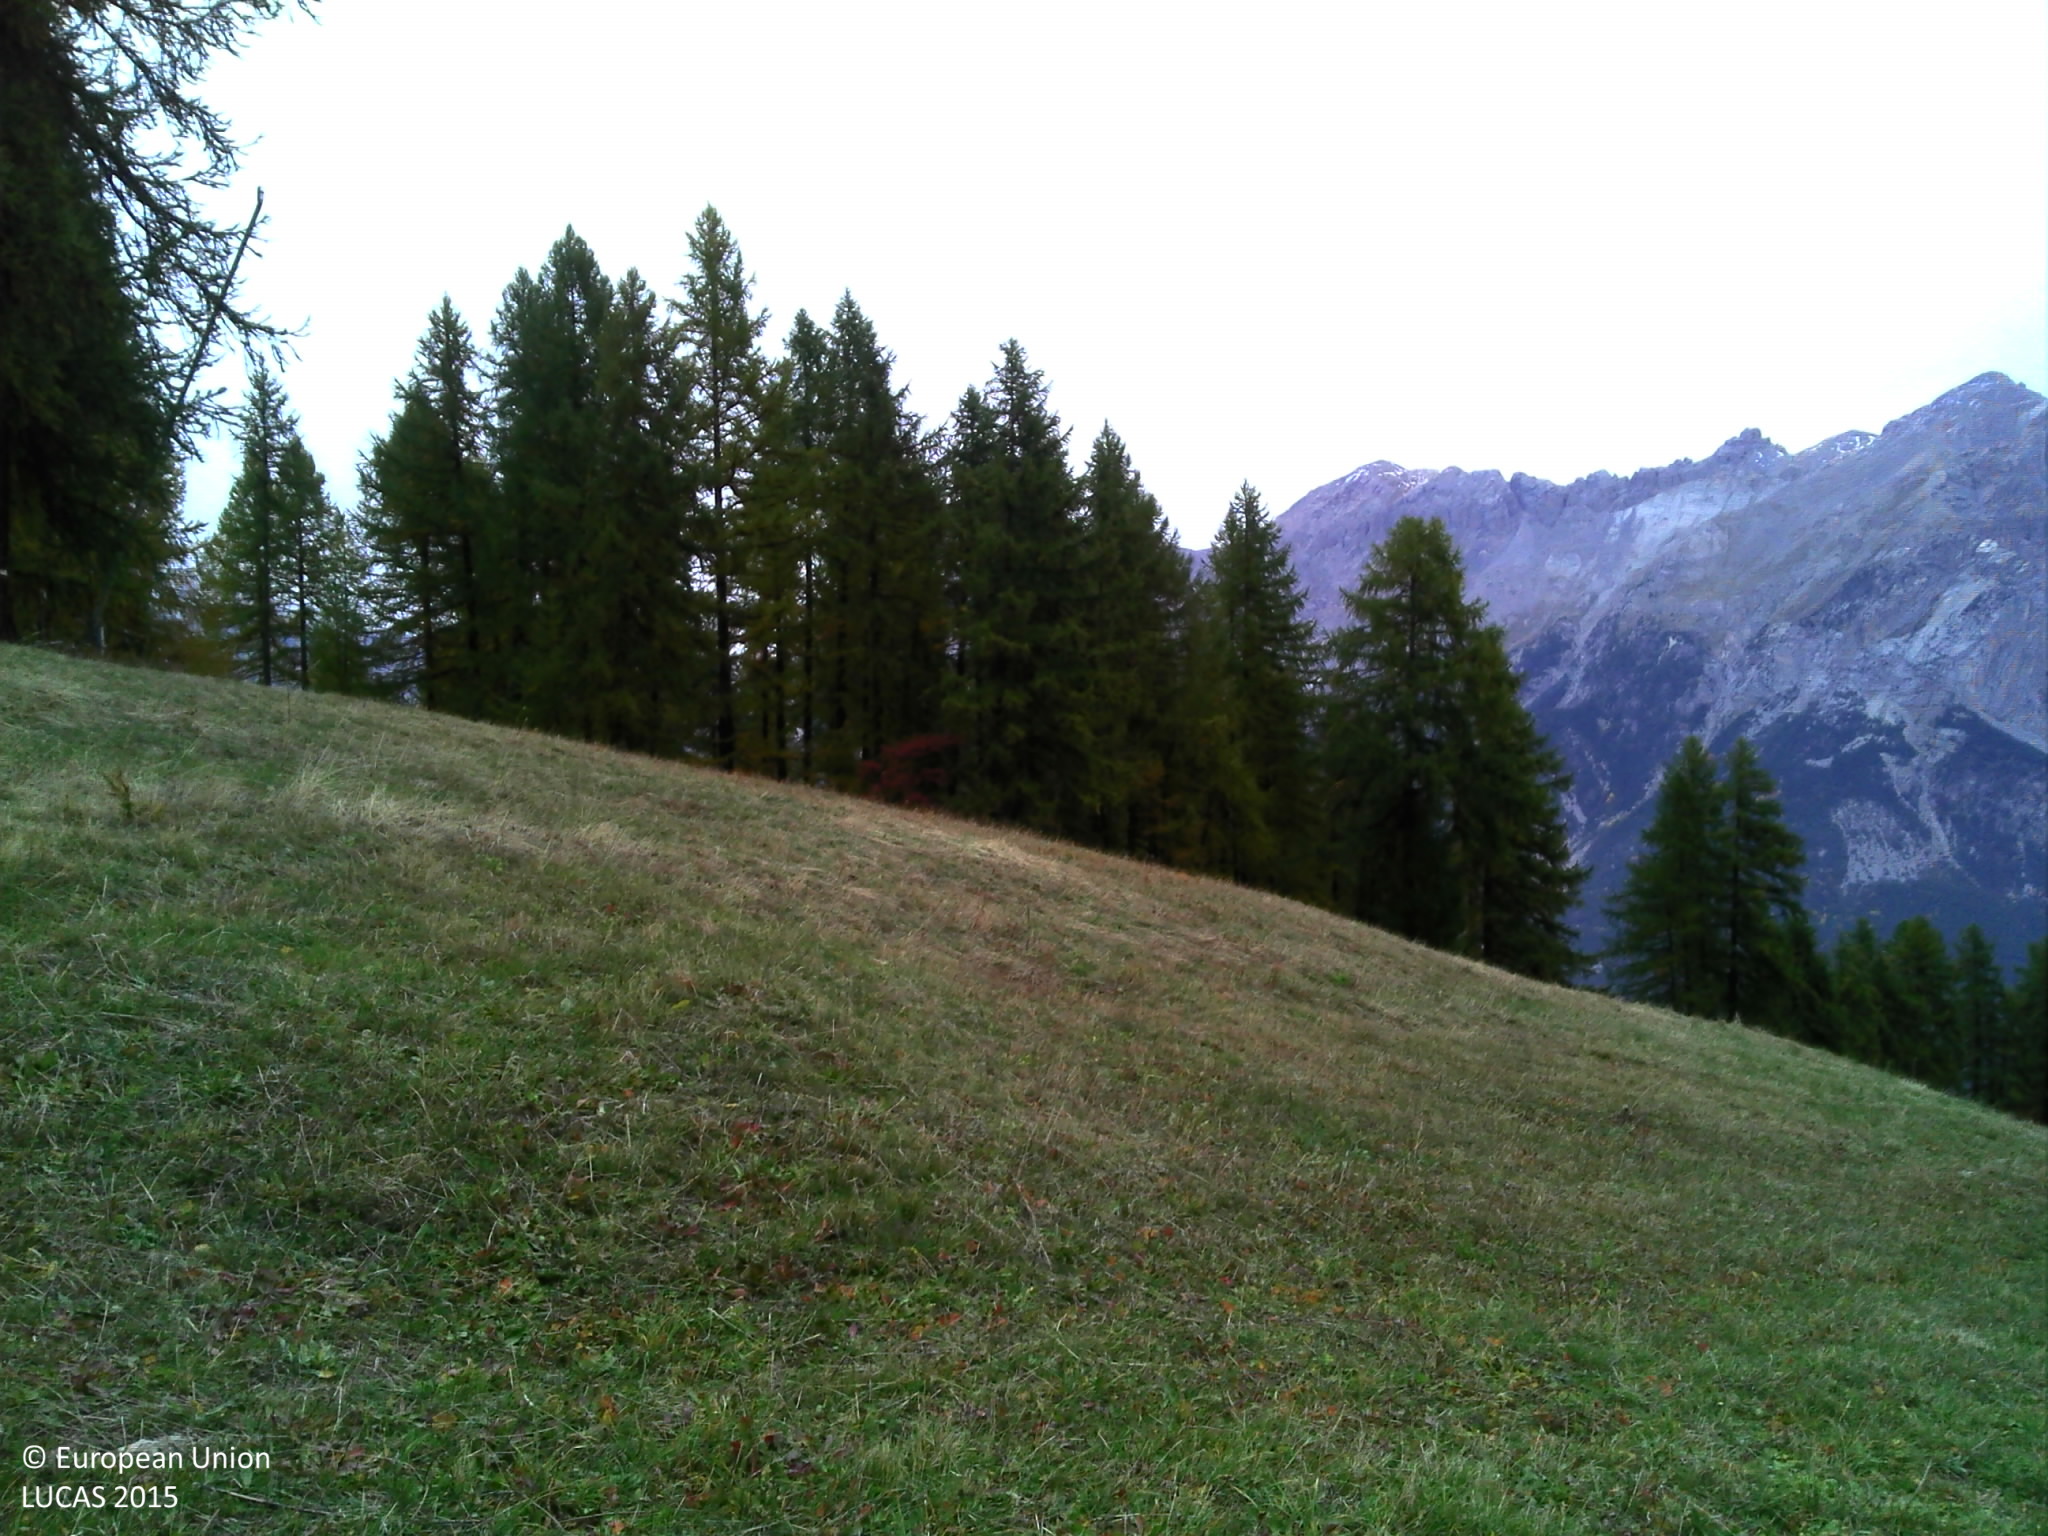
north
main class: Grassland
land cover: Grassland without tree/shrub cover
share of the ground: > 75 %
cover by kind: herbaceous plants 95 %, unconsolidated bare surface 5 %
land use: Agriculture (excluding fallow land and kitchen gardens)
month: October
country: FR
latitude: 44.8142
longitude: 6.4778
